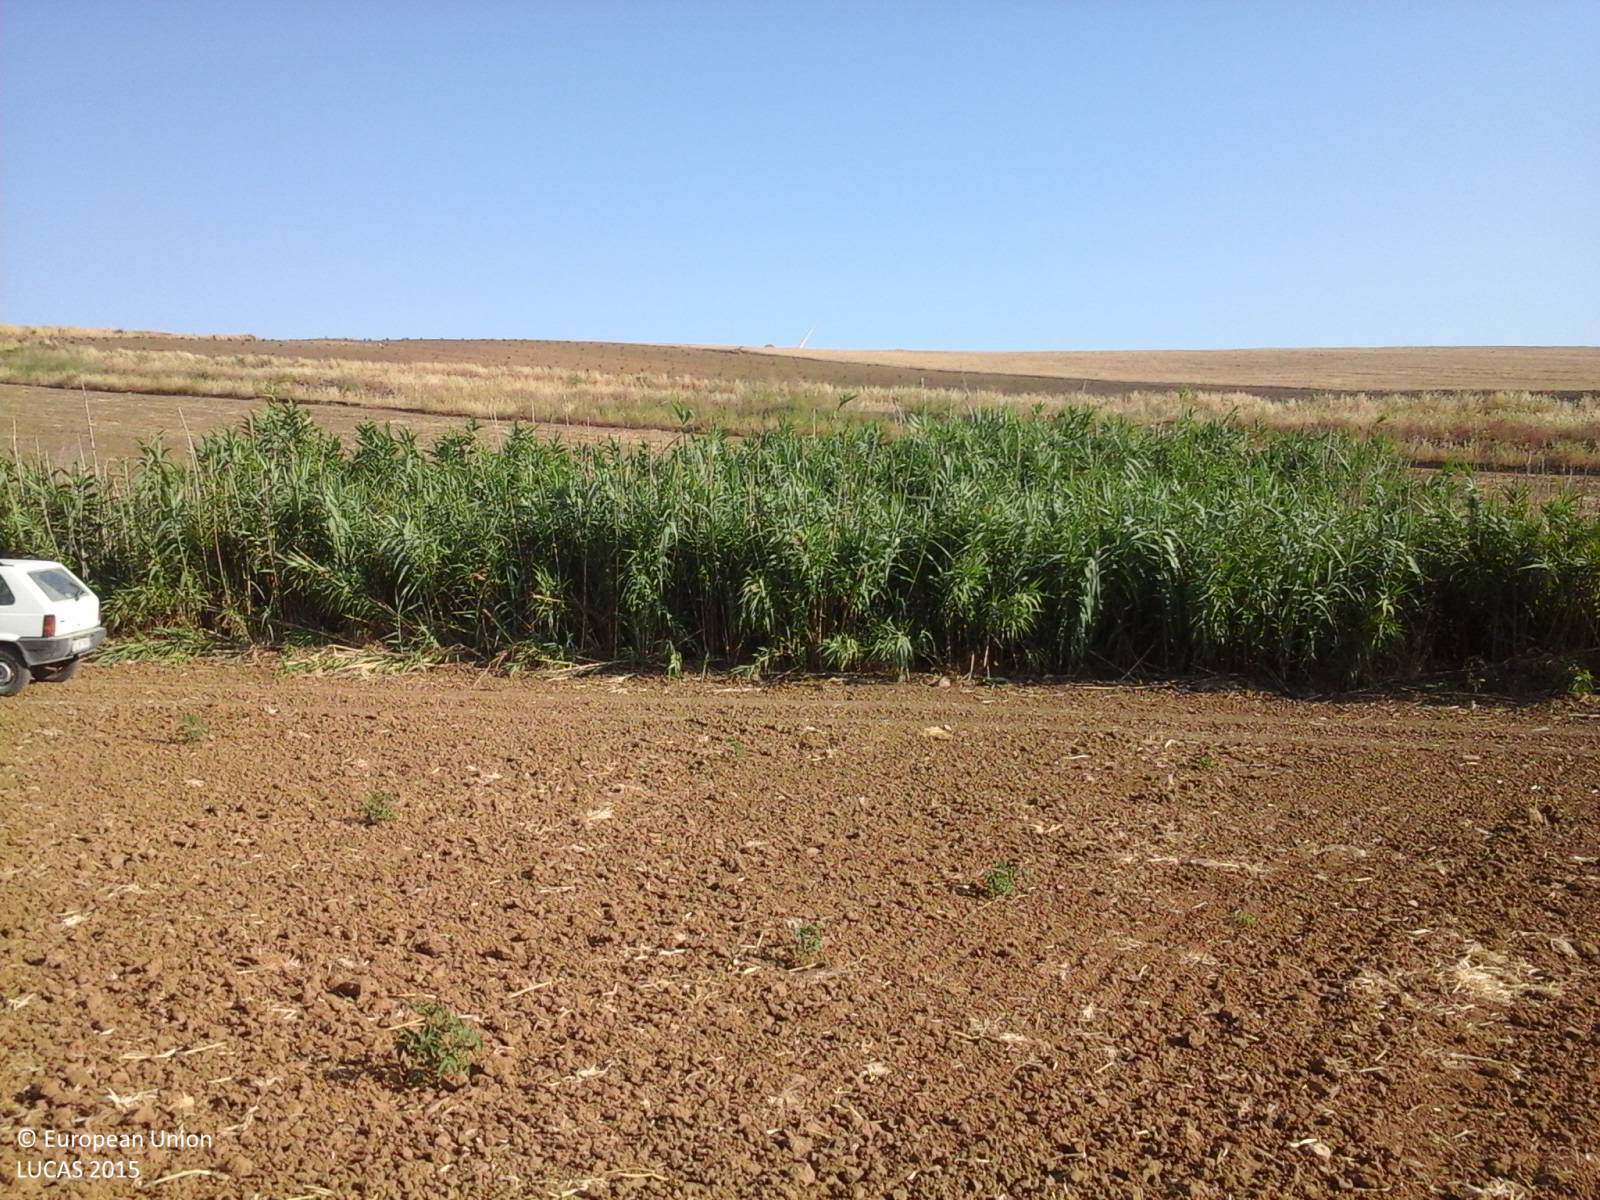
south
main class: Cropland
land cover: Tomatoes
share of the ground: < 10 %
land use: Agriculture (excluding fallow land and kitchen gardens)
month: June
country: IT
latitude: 37.9466
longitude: 12.6548
